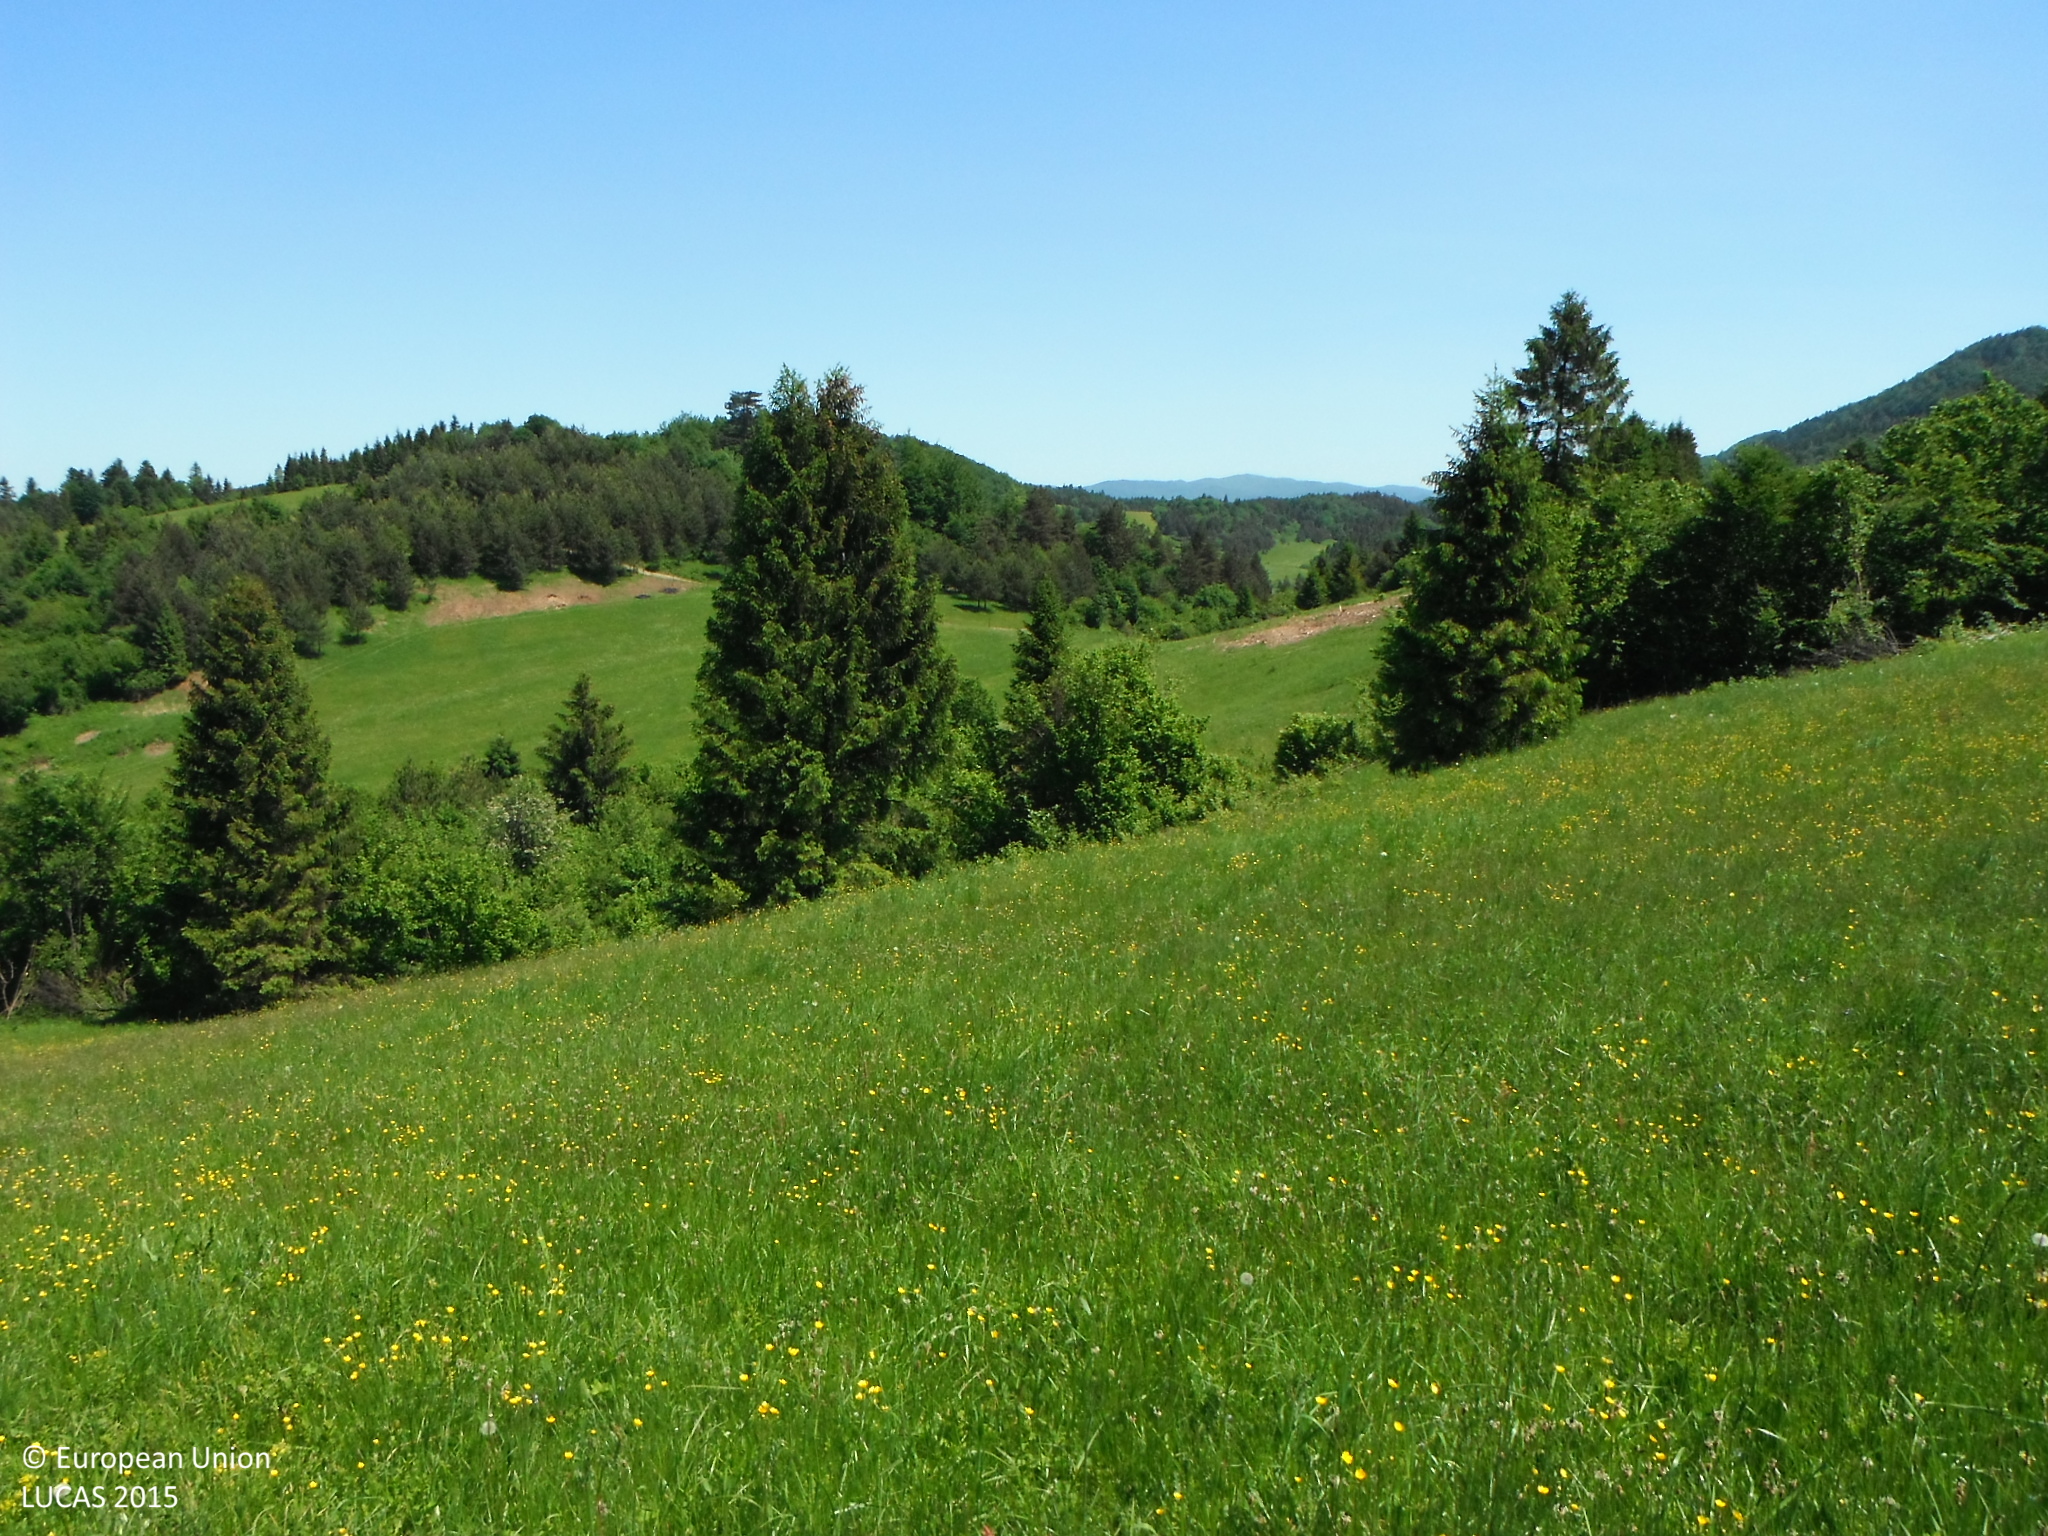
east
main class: Grassland
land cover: Grassland without tree/shrub cover
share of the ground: > 75 %
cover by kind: herbaceous plants 100 %
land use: Agriculture (excluding fallow land and kitchen gardens)
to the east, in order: Grassland without tree/shrub cover; Other mixed woodland; Ditches and canals; Other mixed woodland; Grassland without tree/shrub cover; Other mixed woodland; Grassland without tree/shrub cover
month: June
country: SK
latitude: 49.2400
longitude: 20.7389
